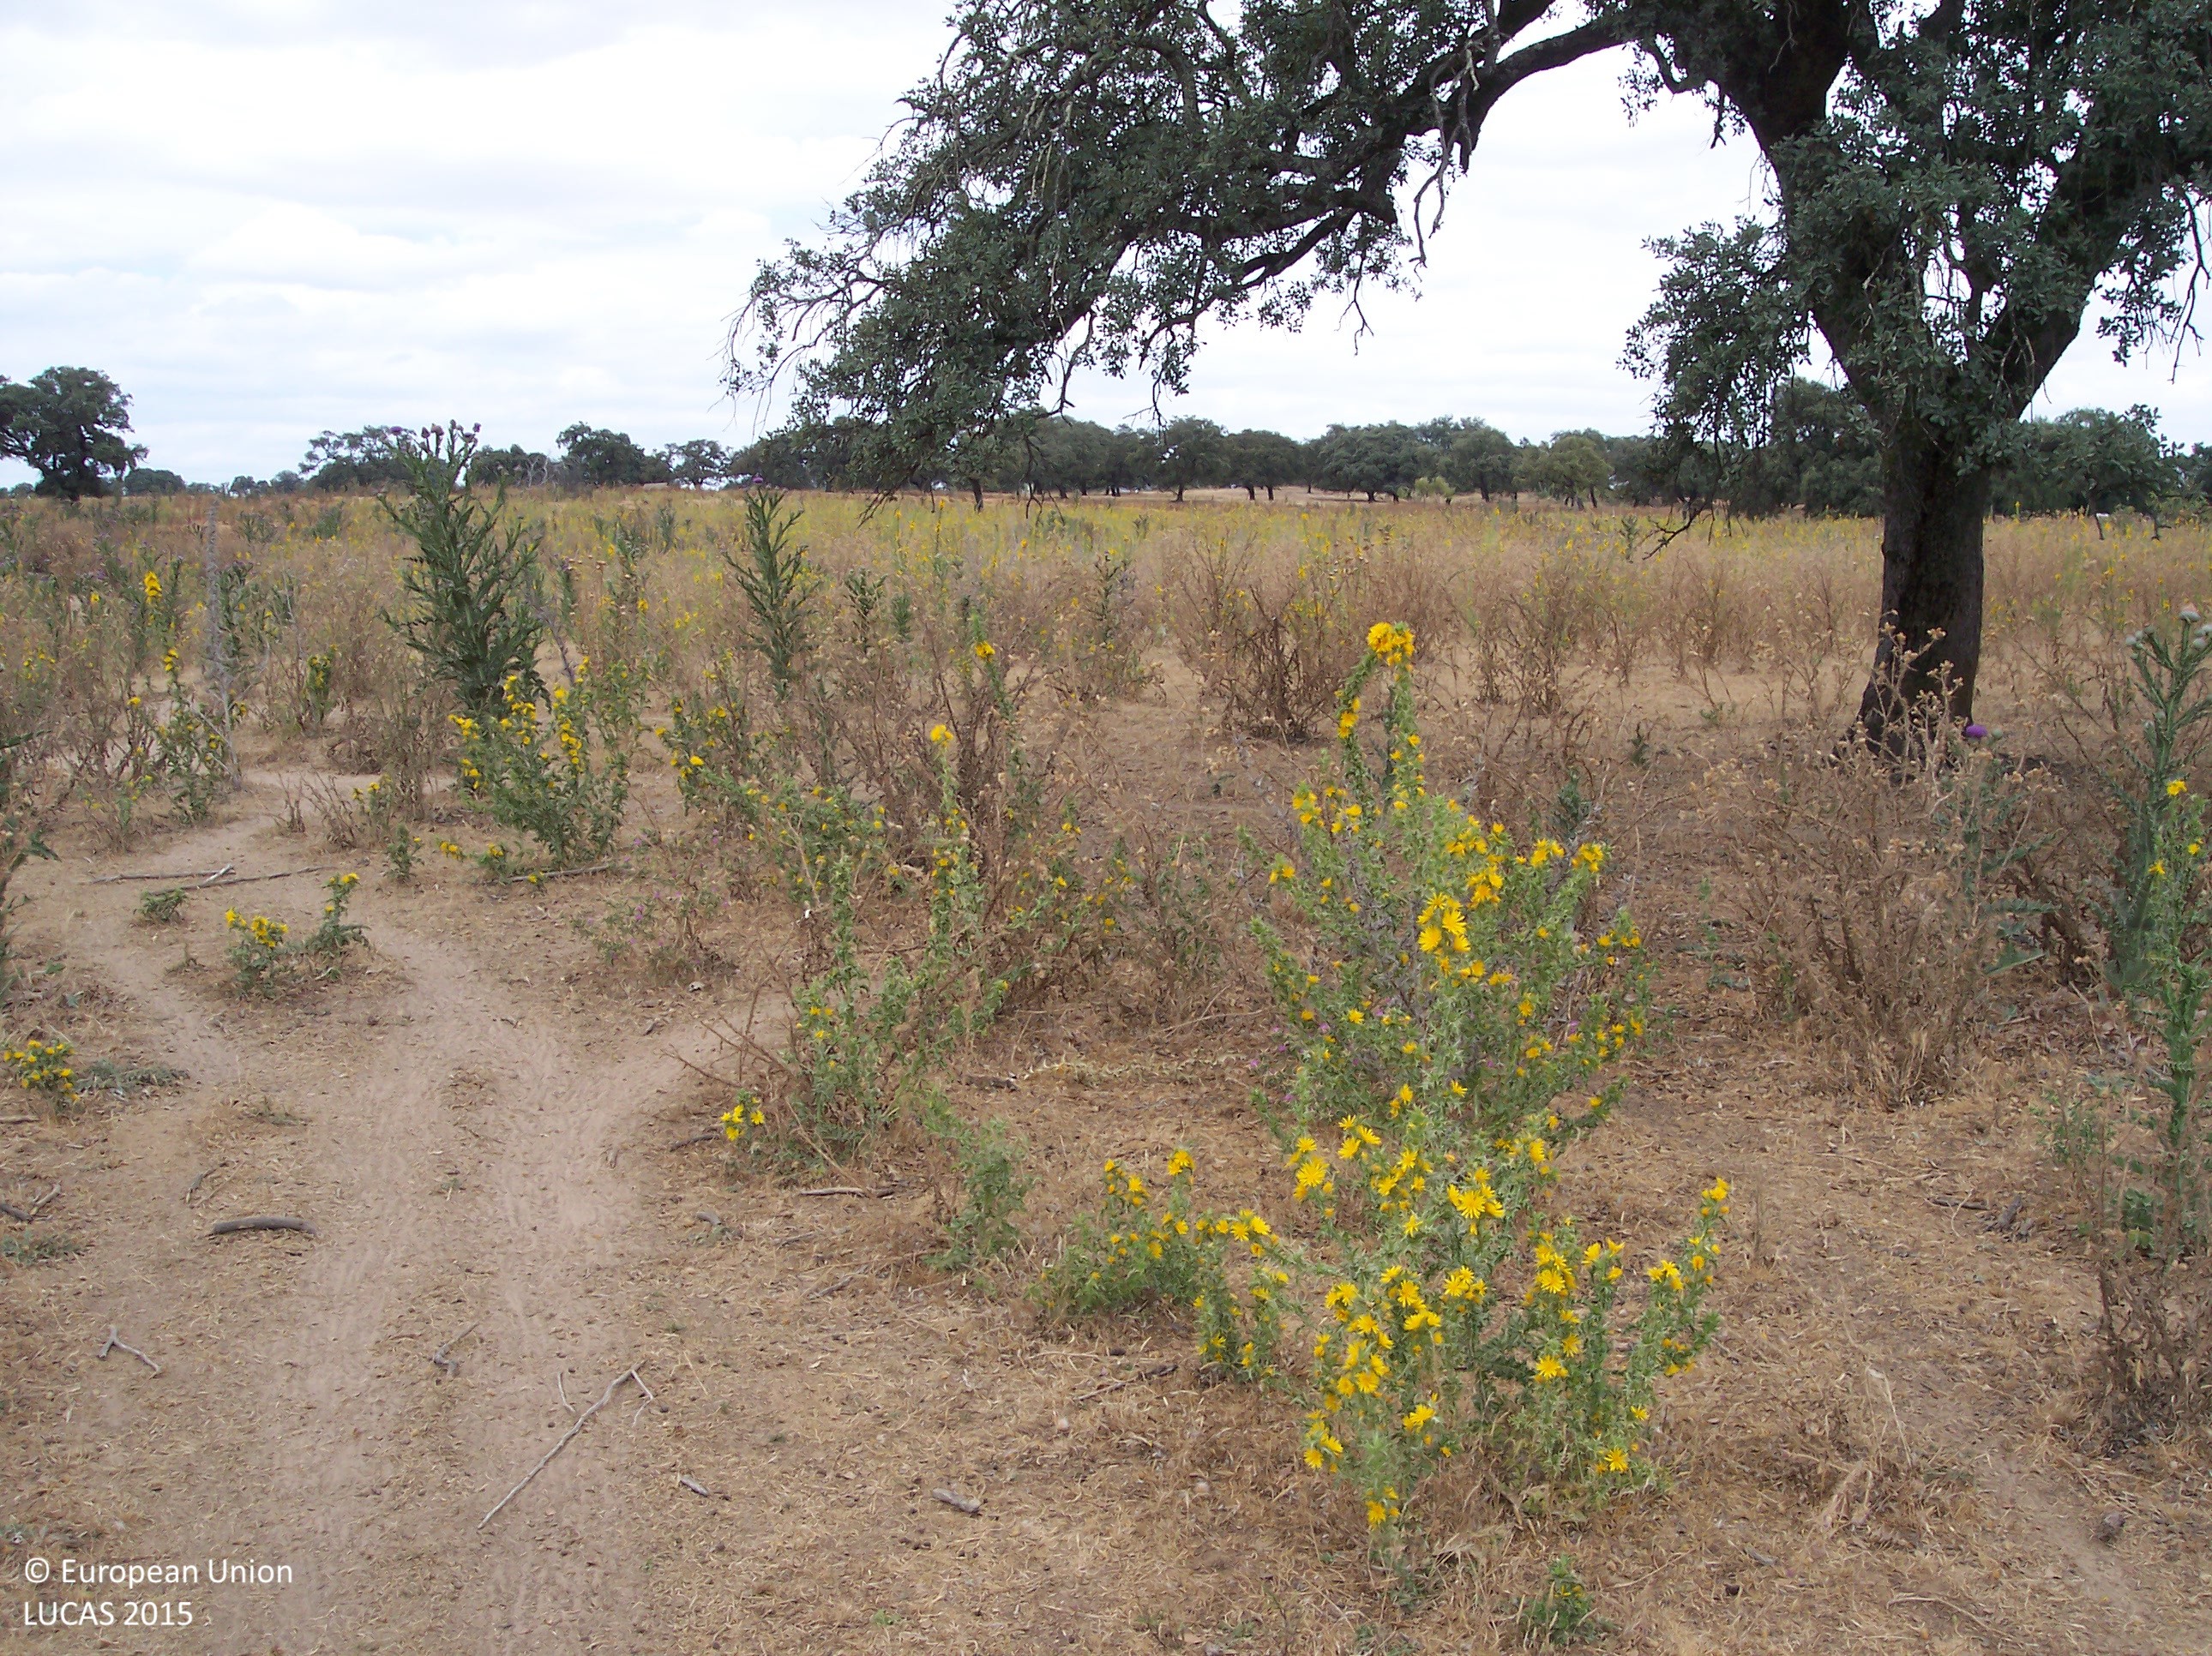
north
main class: Shrubland
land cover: Shrubland with sparse tree cover
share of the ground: 25 - 50 %
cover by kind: unconsolidated bare surface 60 %, shrubs 20 %, herbaceous plants 15 %, broadleaved forest trees 5 %
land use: Agriculture (excluding fallow land and kitchen gardens)
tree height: > 5 m
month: June
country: ES
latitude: 37.3273
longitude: -6.4049
